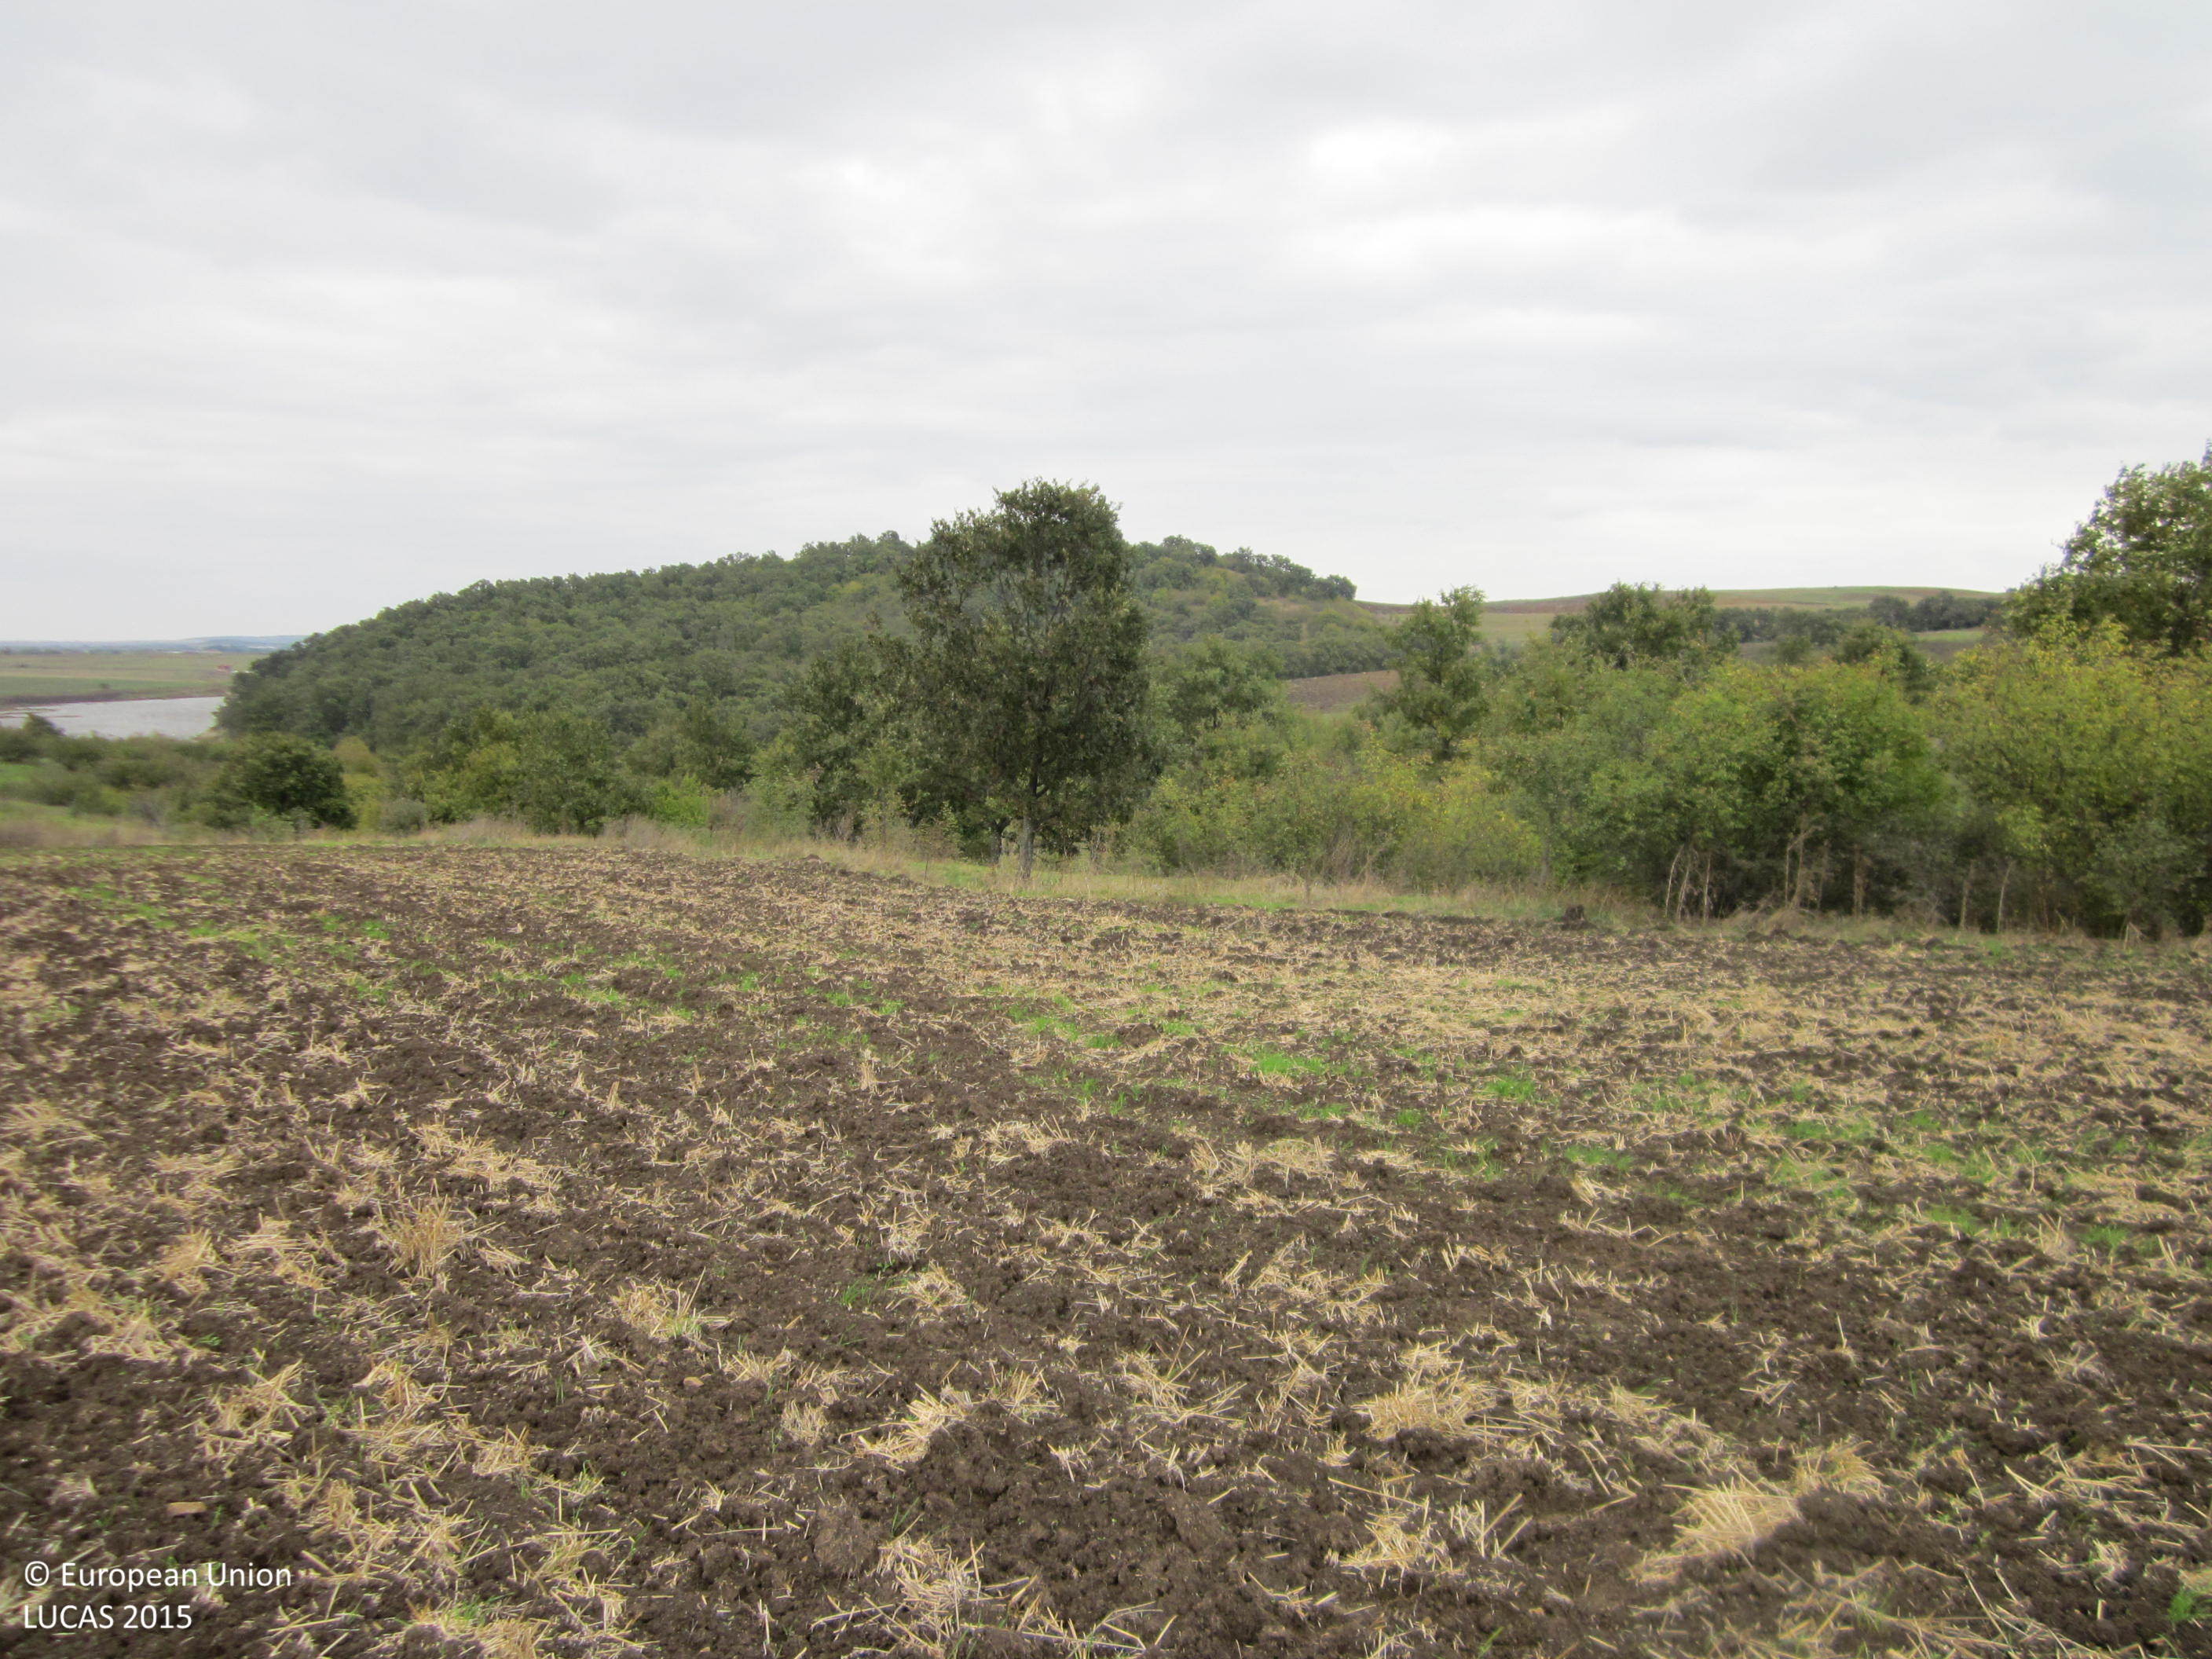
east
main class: Cropland
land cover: Common wheat
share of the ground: < 10 %
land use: Agriculture (excluding fallow land and kitchen gardens)
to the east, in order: Common wheat; Grassland with sparse tree/shrub cover; Shrubland with sparse tree cover
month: October
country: BG
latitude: 42.3739
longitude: 26.9455
